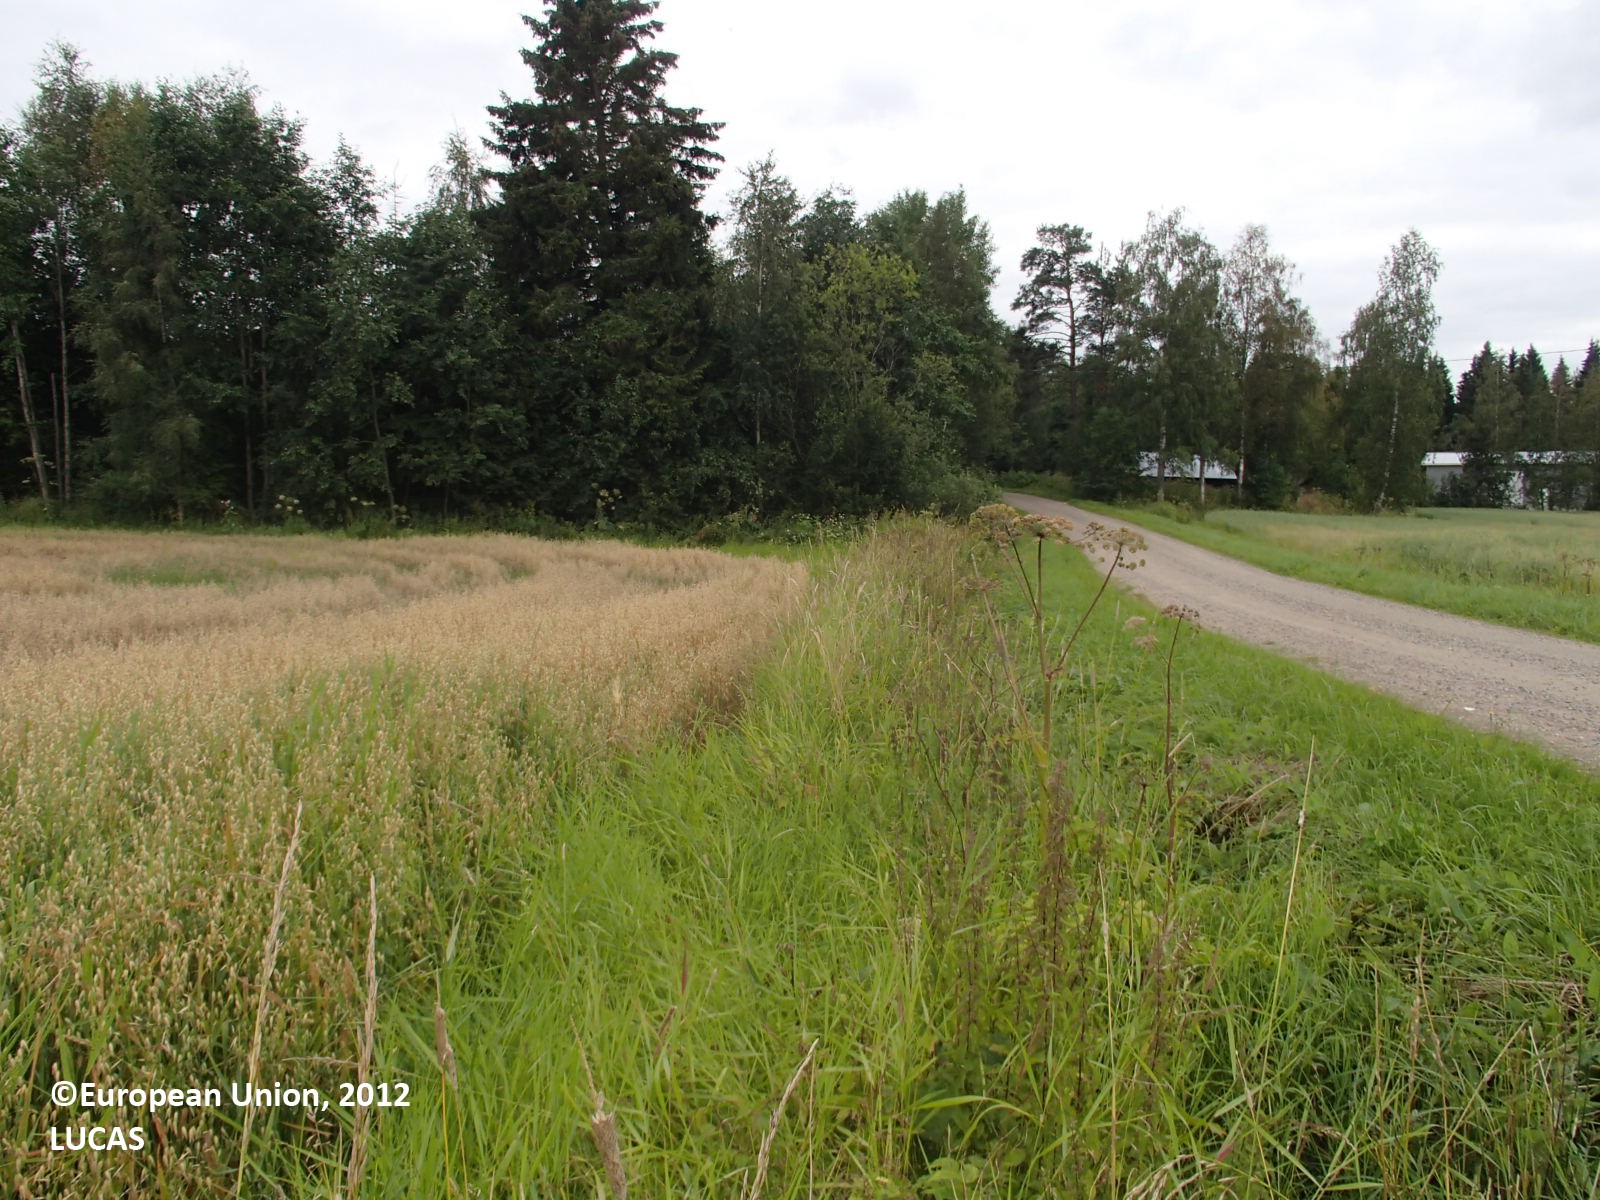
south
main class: Cropland
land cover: Oats
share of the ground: > 75 %
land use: Agriculture (excluding fallow land and kitchen gardens)
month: August
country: FI
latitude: 63.6335
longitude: 27.1988
